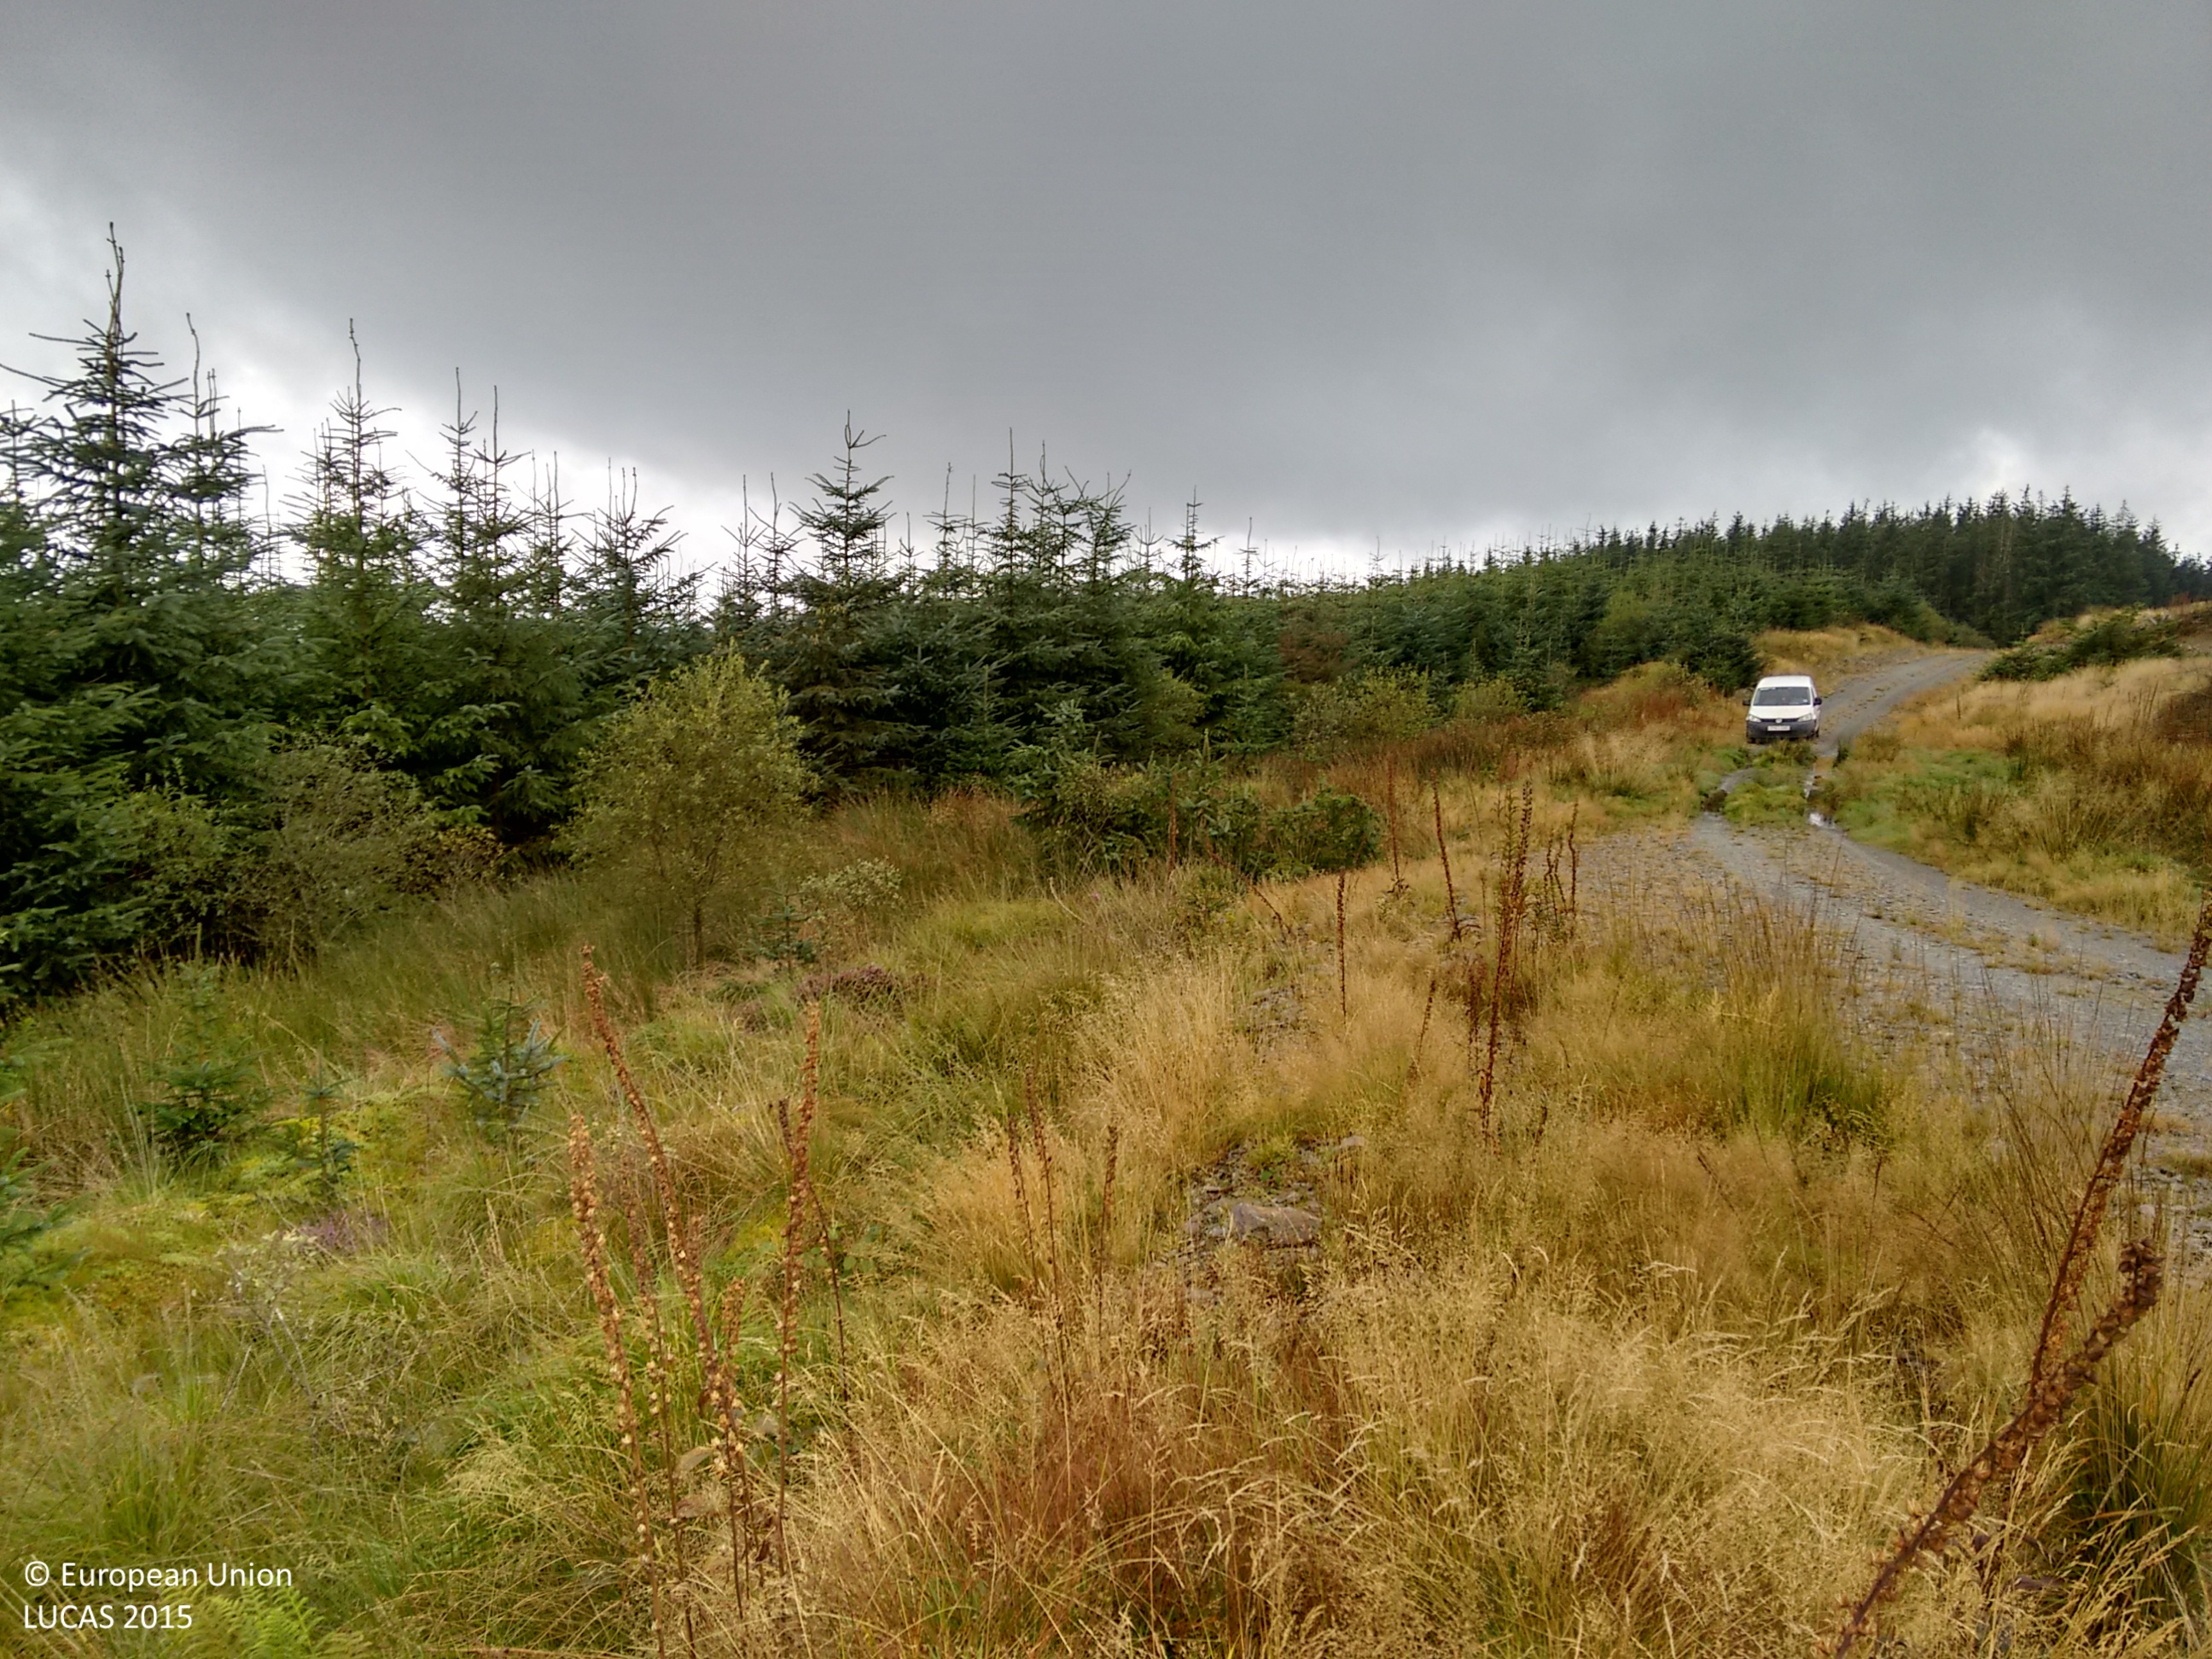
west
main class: Woodland
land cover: Spruce dominated coniferous woodland
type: exotic forest
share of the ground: > 75 %
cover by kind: coniferous forest trees 70 %, herbaceous plants 30 %
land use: Forestry
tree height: < 5 m
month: September
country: GB
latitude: 52.1589
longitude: -3.7273
